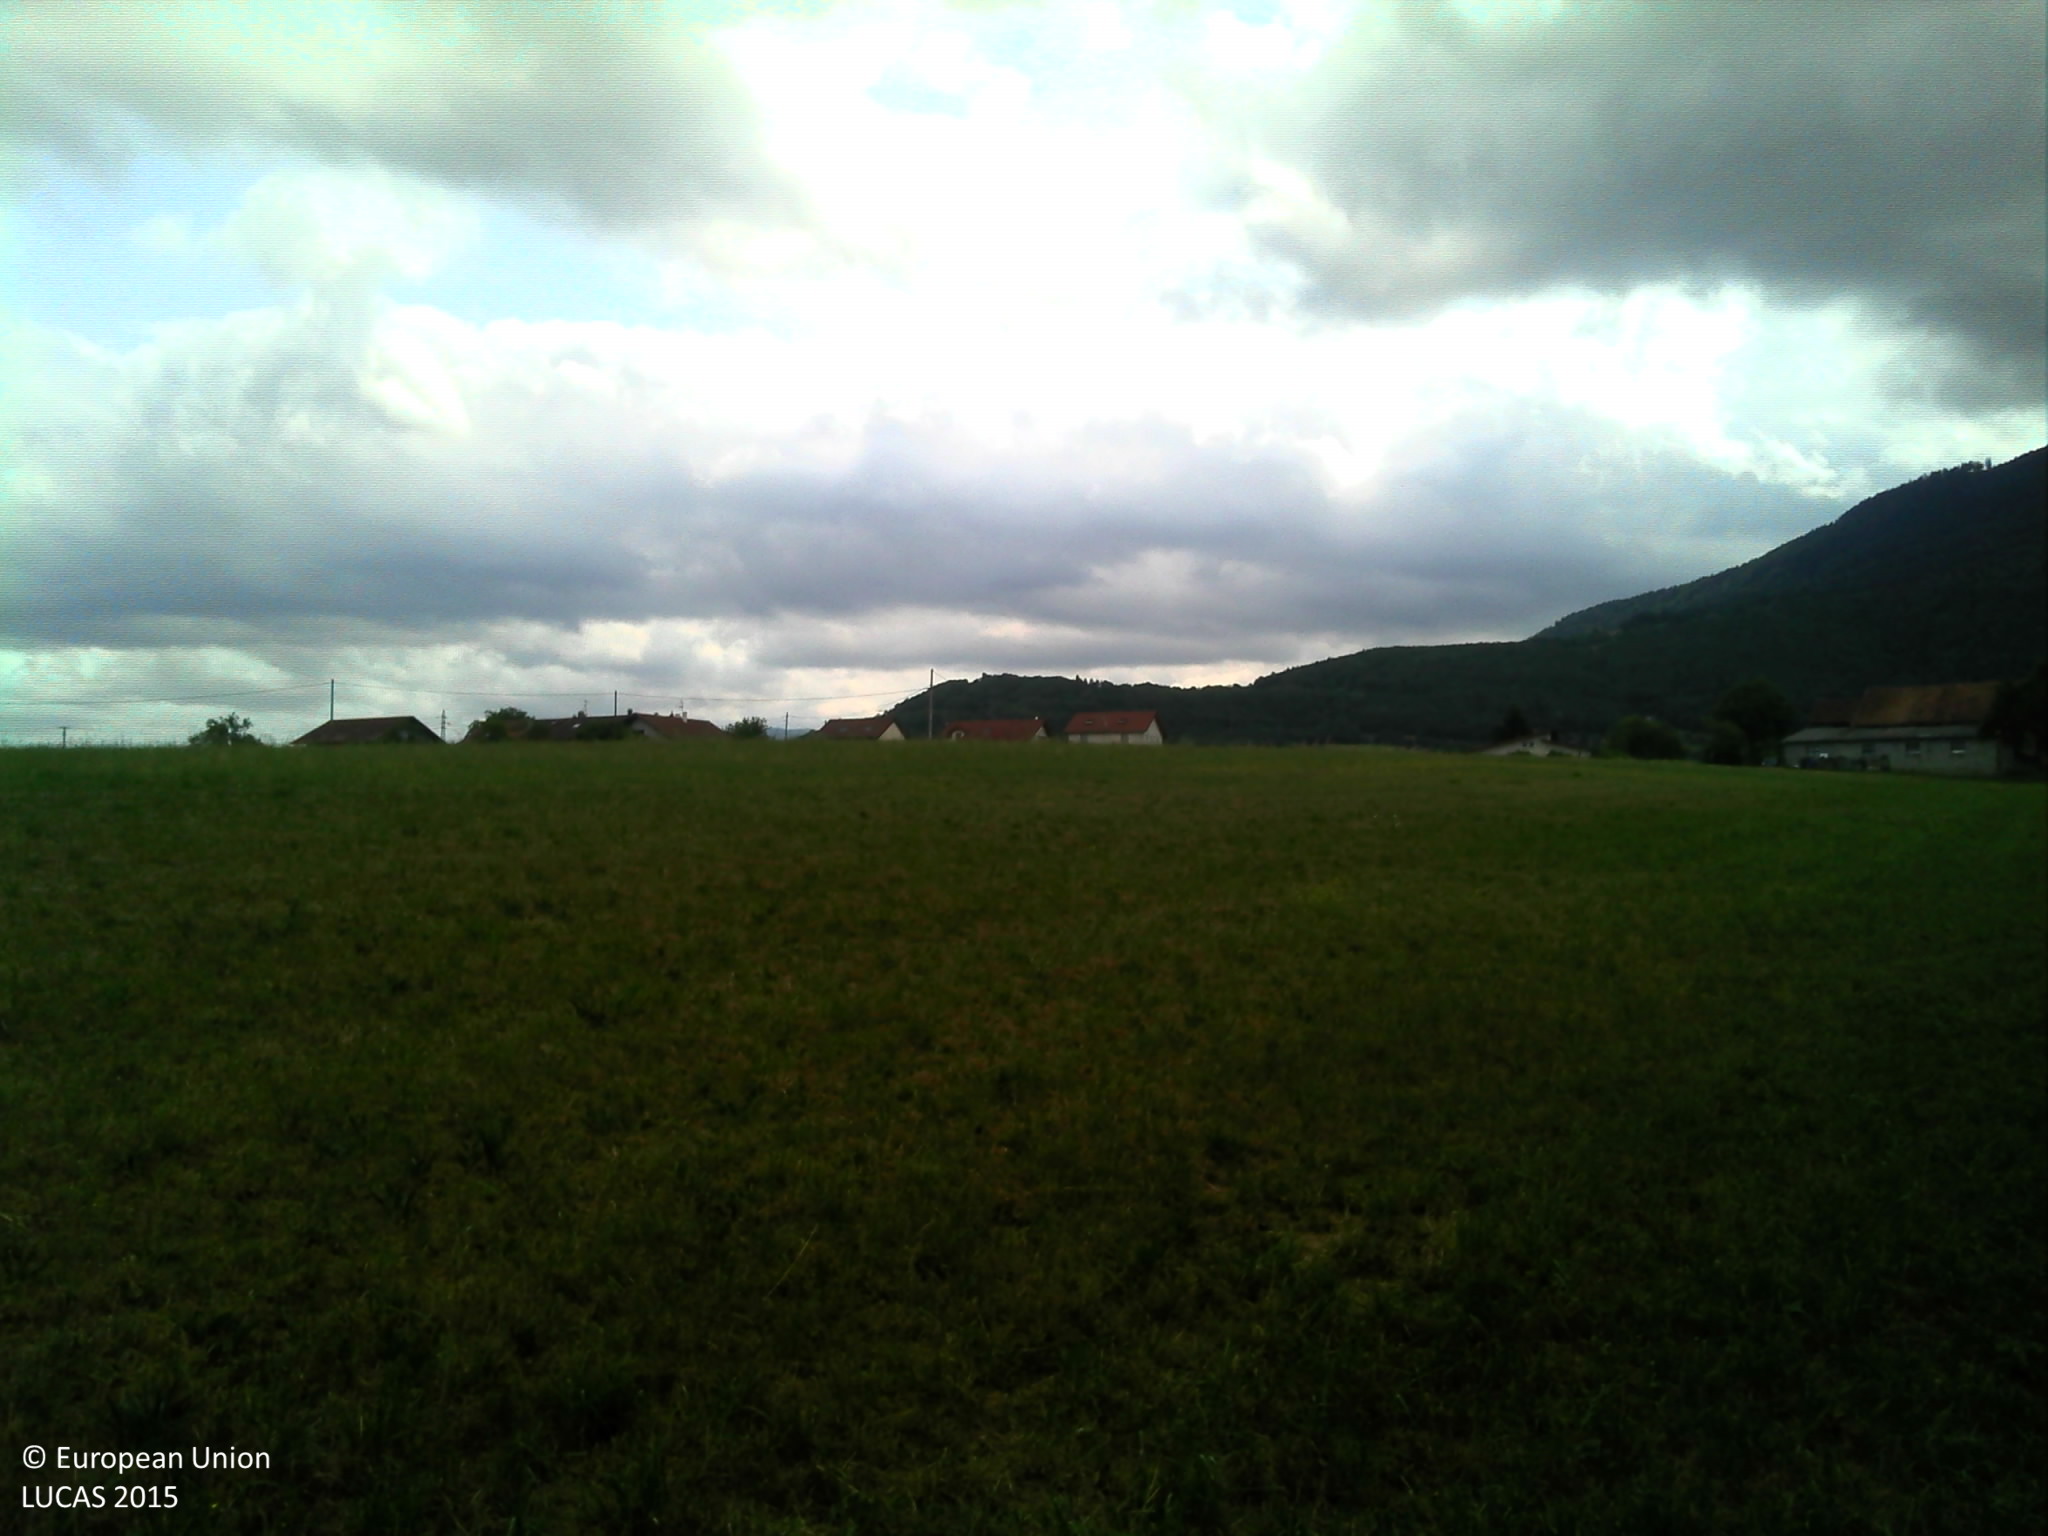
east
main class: Grassland
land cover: Grassland without tree/shrub cover
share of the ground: > 75 %
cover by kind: herbaceous plants 100 %
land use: Agriculture (excluding fallow land and kitchen gardens)
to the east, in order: Grassland without tree/shrub cover; Other leguminous and mixtures for fodder; Fences; Grassland without tree/shrub cover; Electric lines; Grassland without tree/shrub cover; Artificial constructions in urban areas
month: July
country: FR
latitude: 46.2514
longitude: 6.3066
